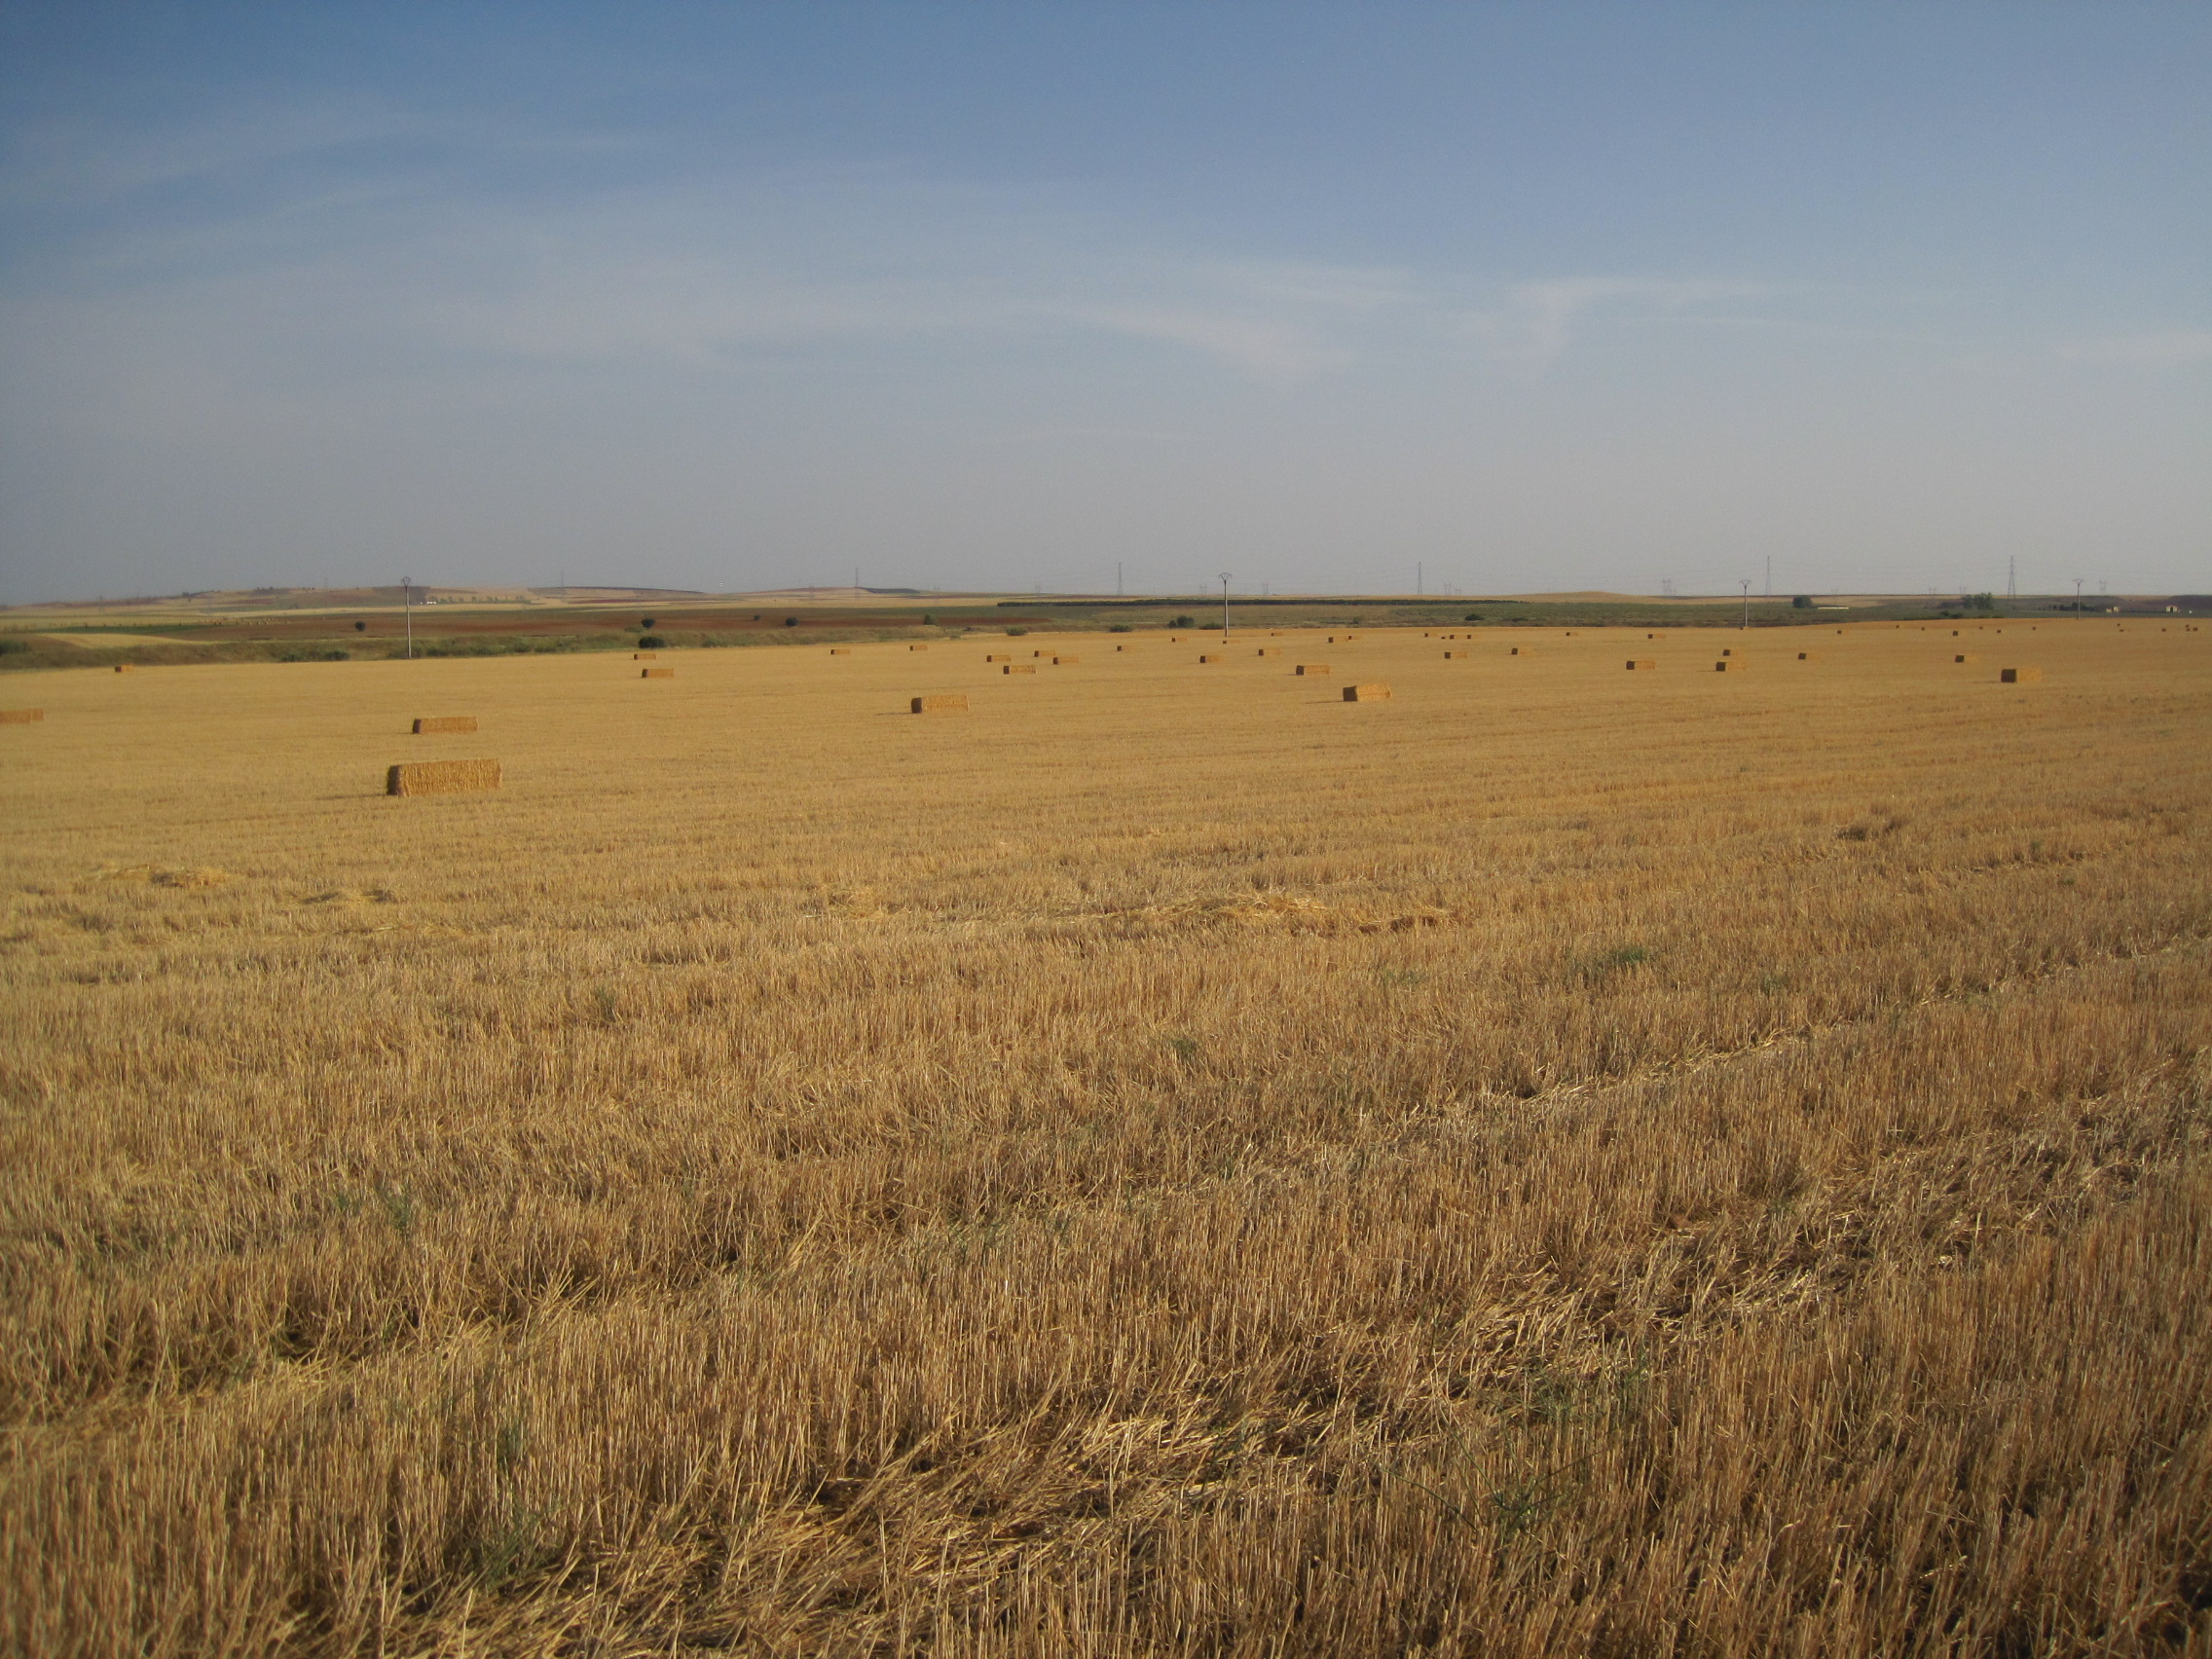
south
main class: Cropland
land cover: Common wheat
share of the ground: < 10 %
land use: Agriculture (excluding fallow land and kitchen gardens)
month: July
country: ES
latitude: 41.7015
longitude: -5.5508
